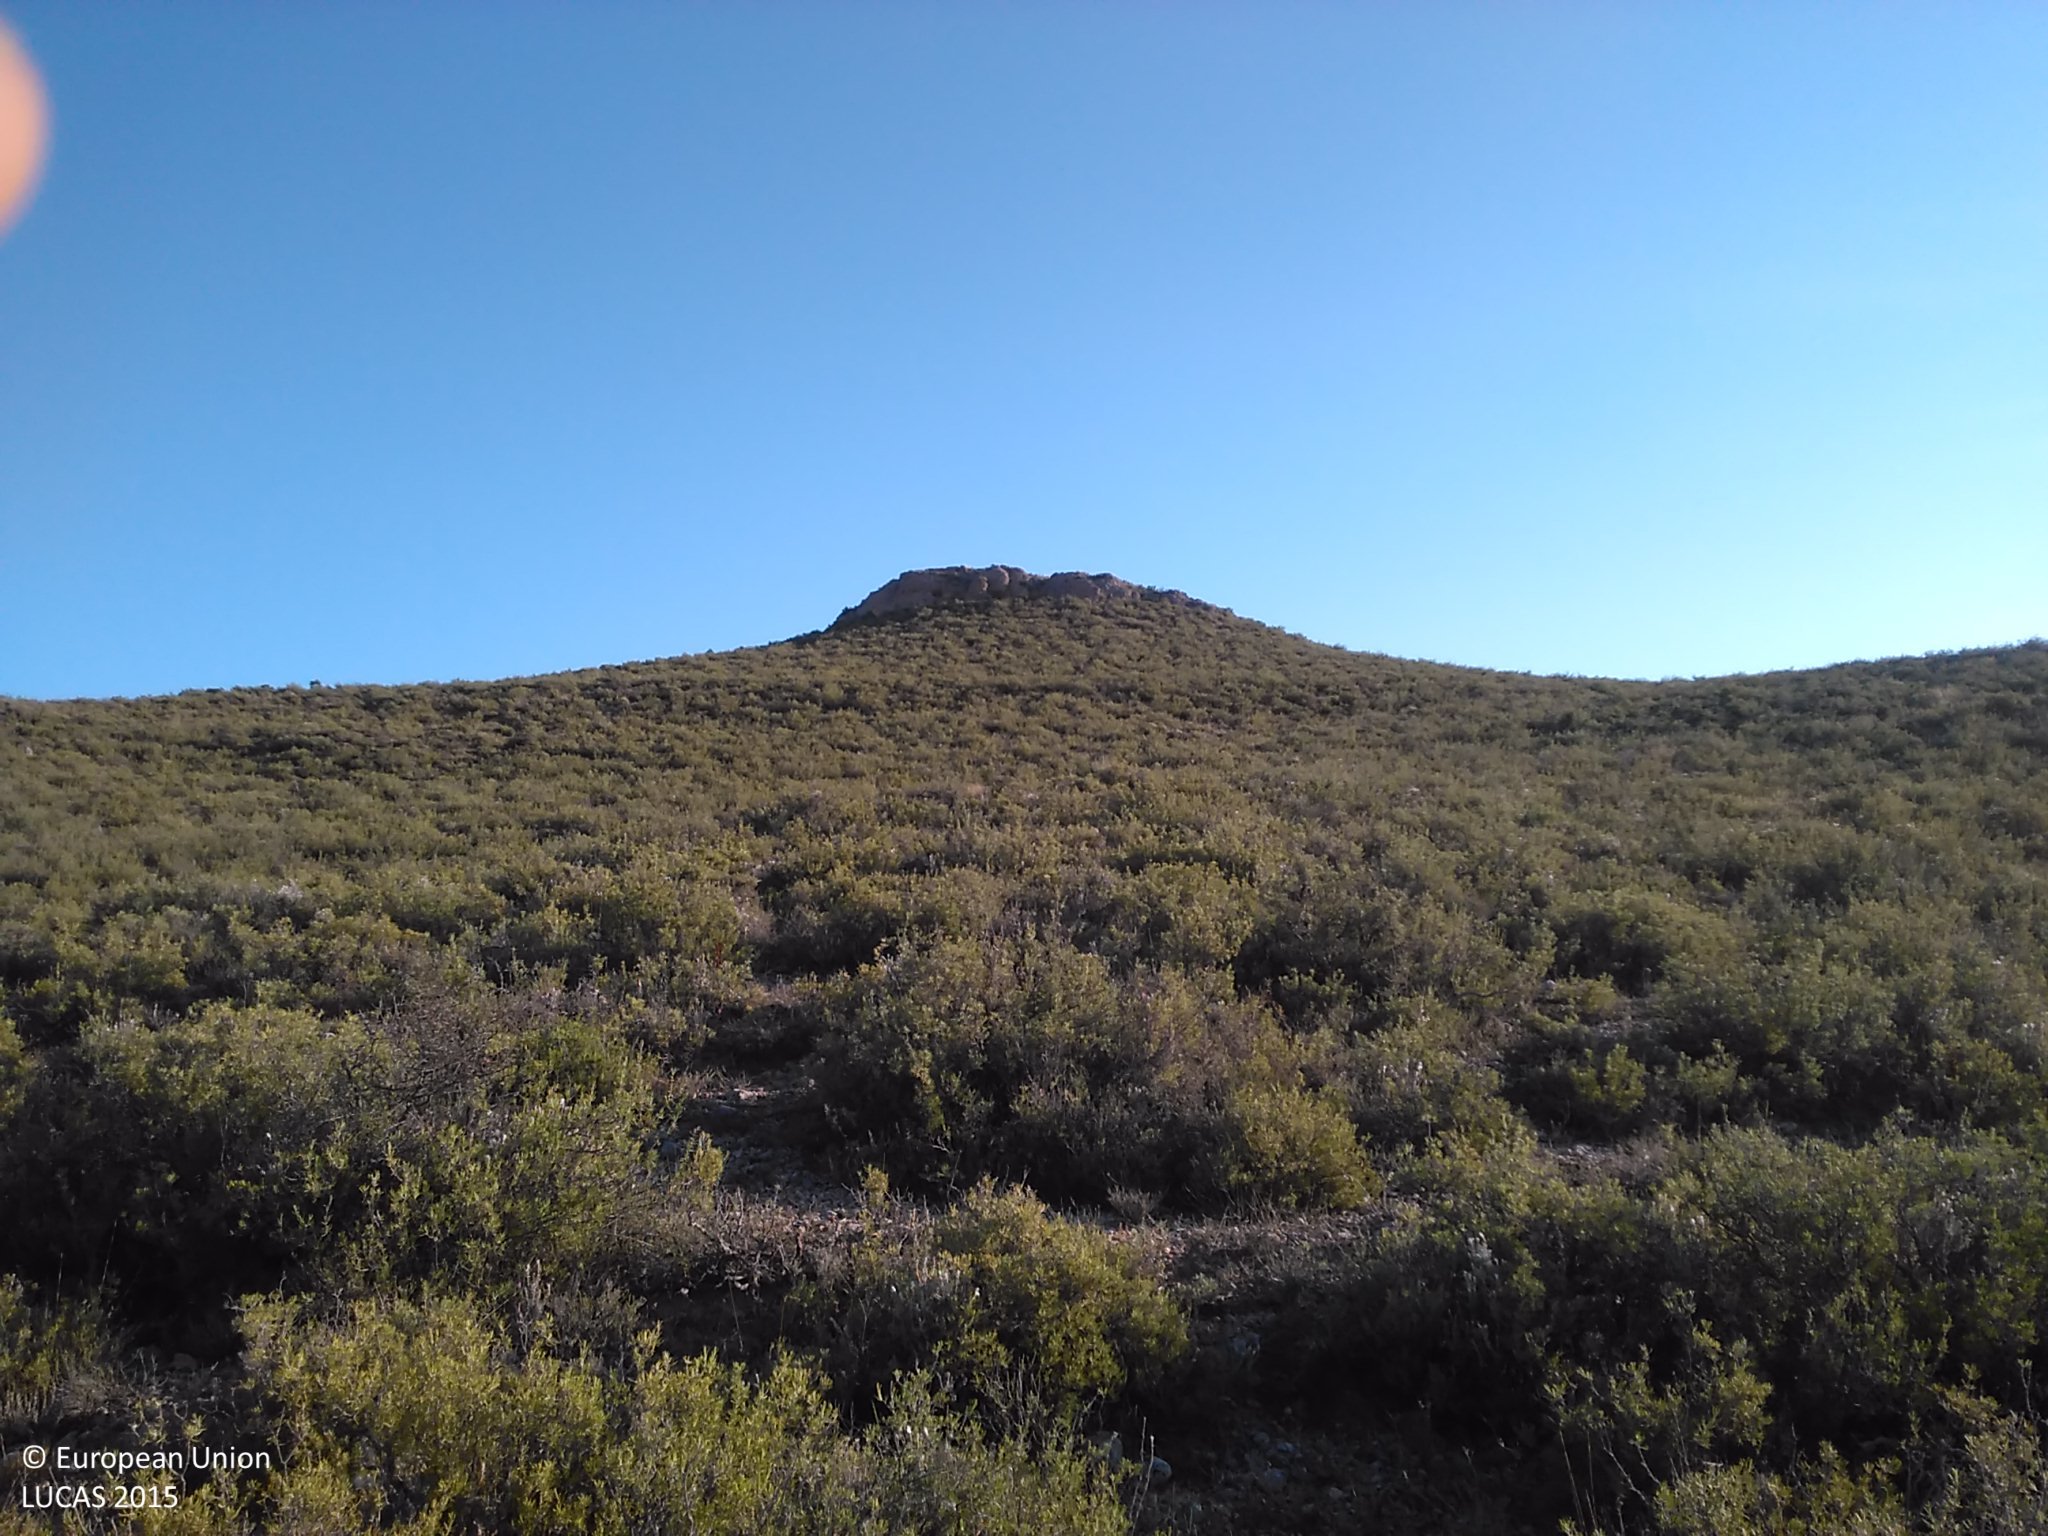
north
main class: Shrubland
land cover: Shrubland without tree cover
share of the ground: 50 - 75 %
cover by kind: shrubs 60 %, unconsolidated bare surface 35 %, herbaceous plants 5 %
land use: Semi-natural and natural areas not in use
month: July
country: ES
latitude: 41.4801
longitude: -2.1632
